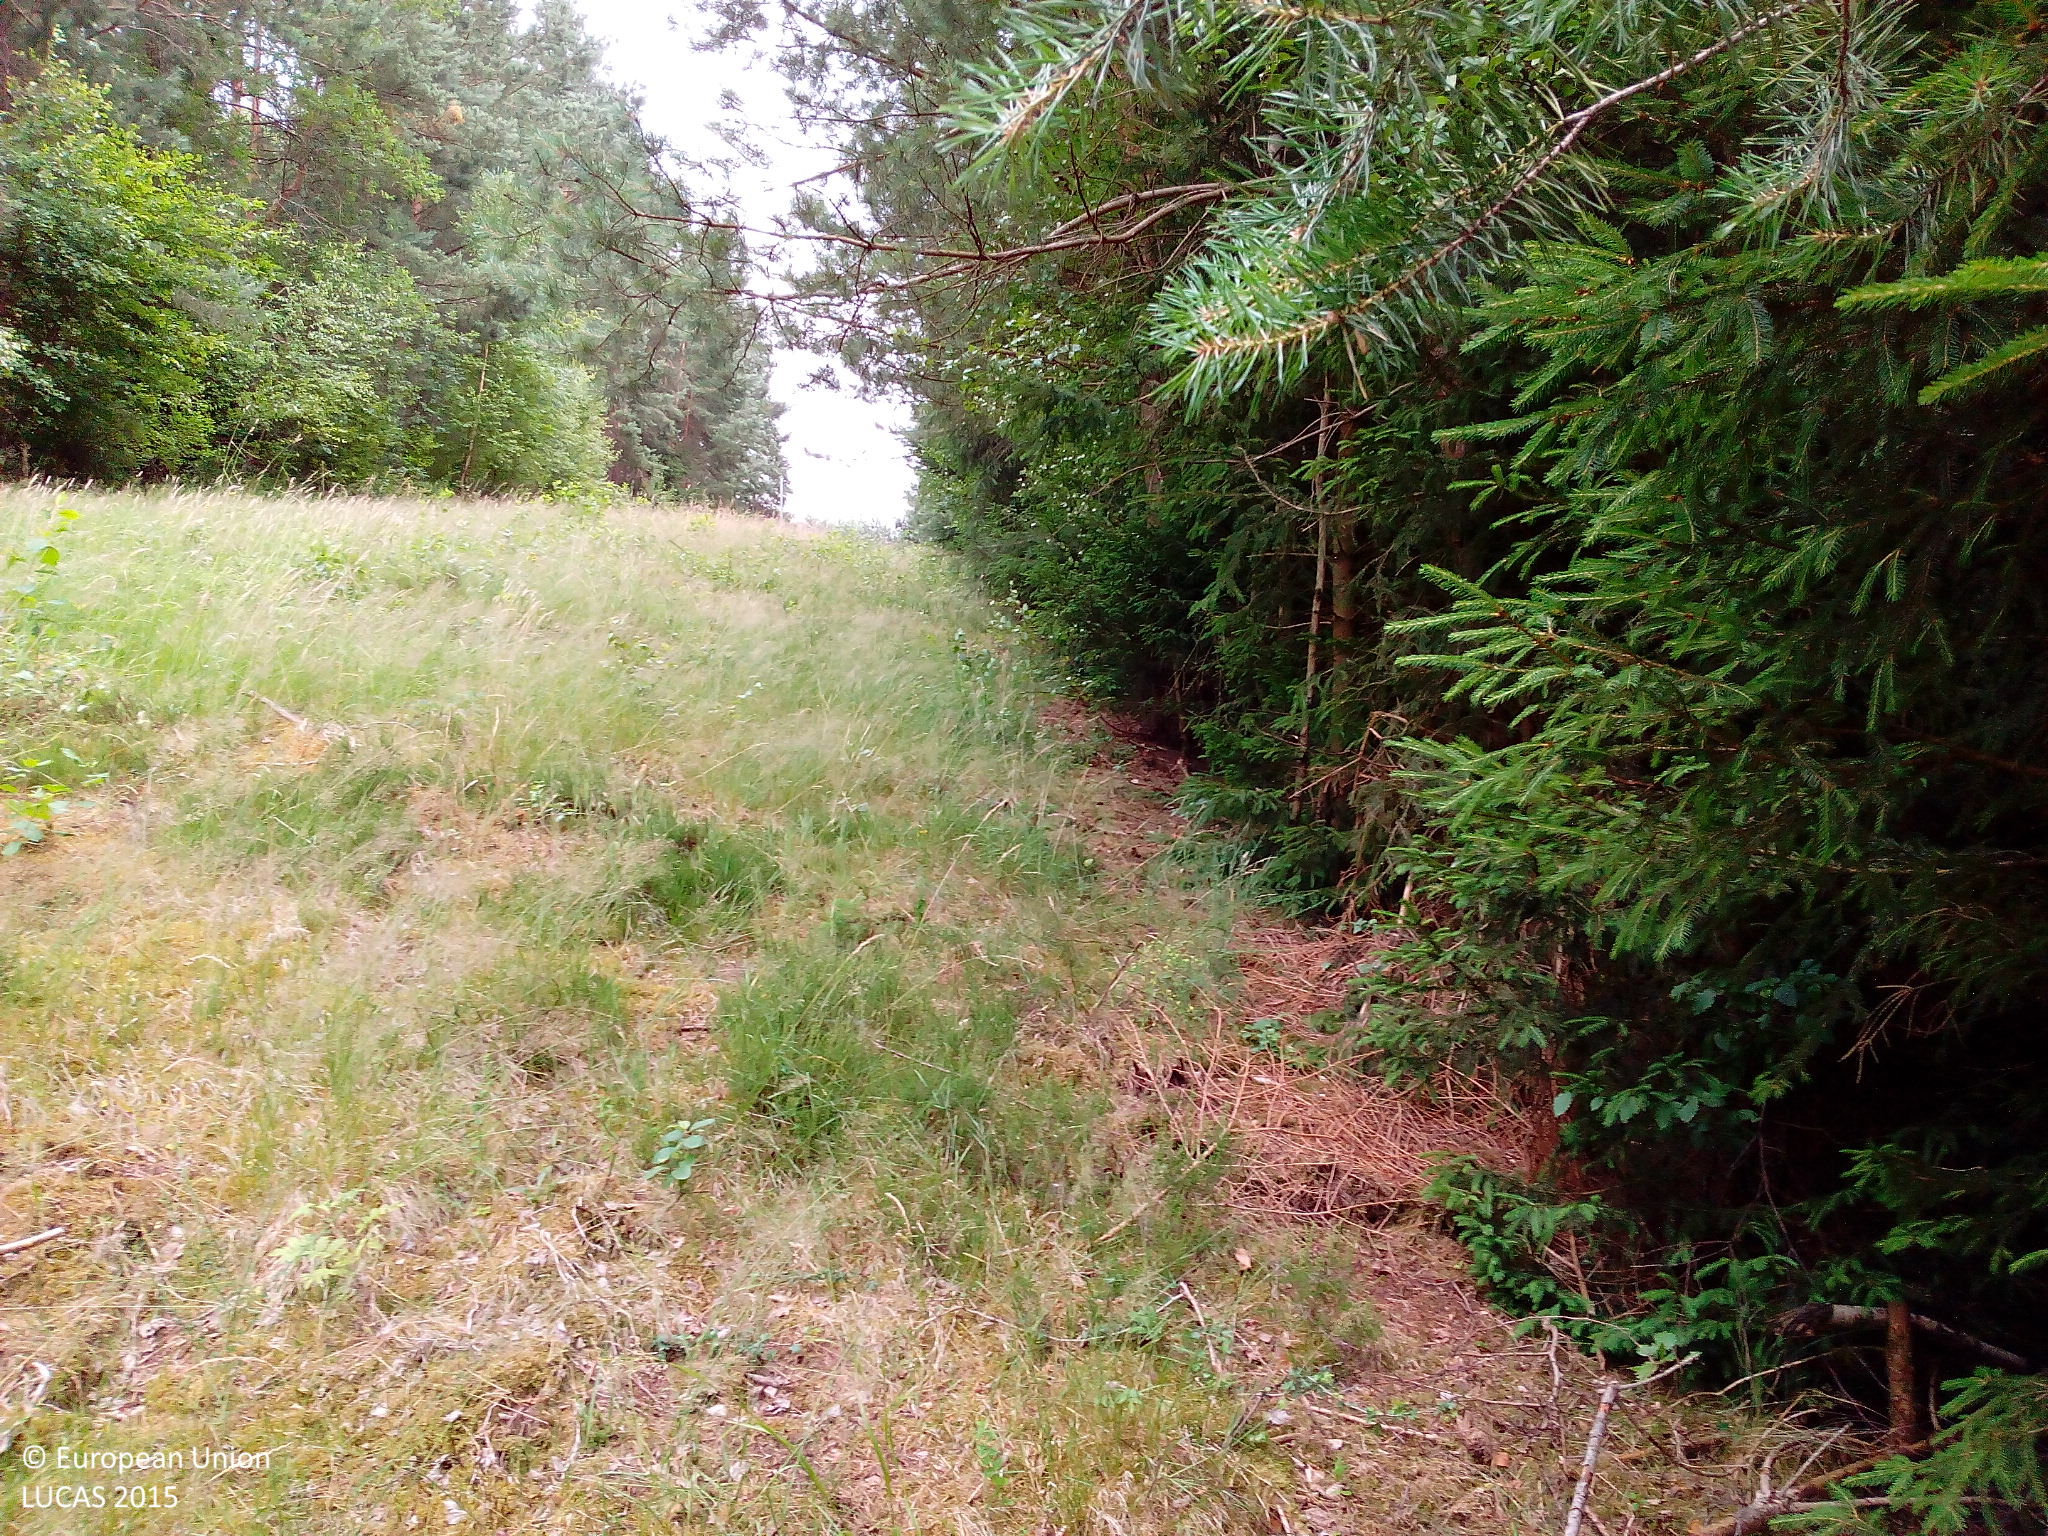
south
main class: Woodland
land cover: Spruce dominated mixed woodland
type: hemiboreal forest and nemoral coniferous forest and mixed broadleaved-coniferous forest
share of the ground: > 75 %
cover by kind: coniferous forest trees 60 %, broadleaved forest trees 40 %
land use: Forestry
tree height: > 5 m
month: July
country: DE
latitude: 50.8135
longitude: 9.9574
